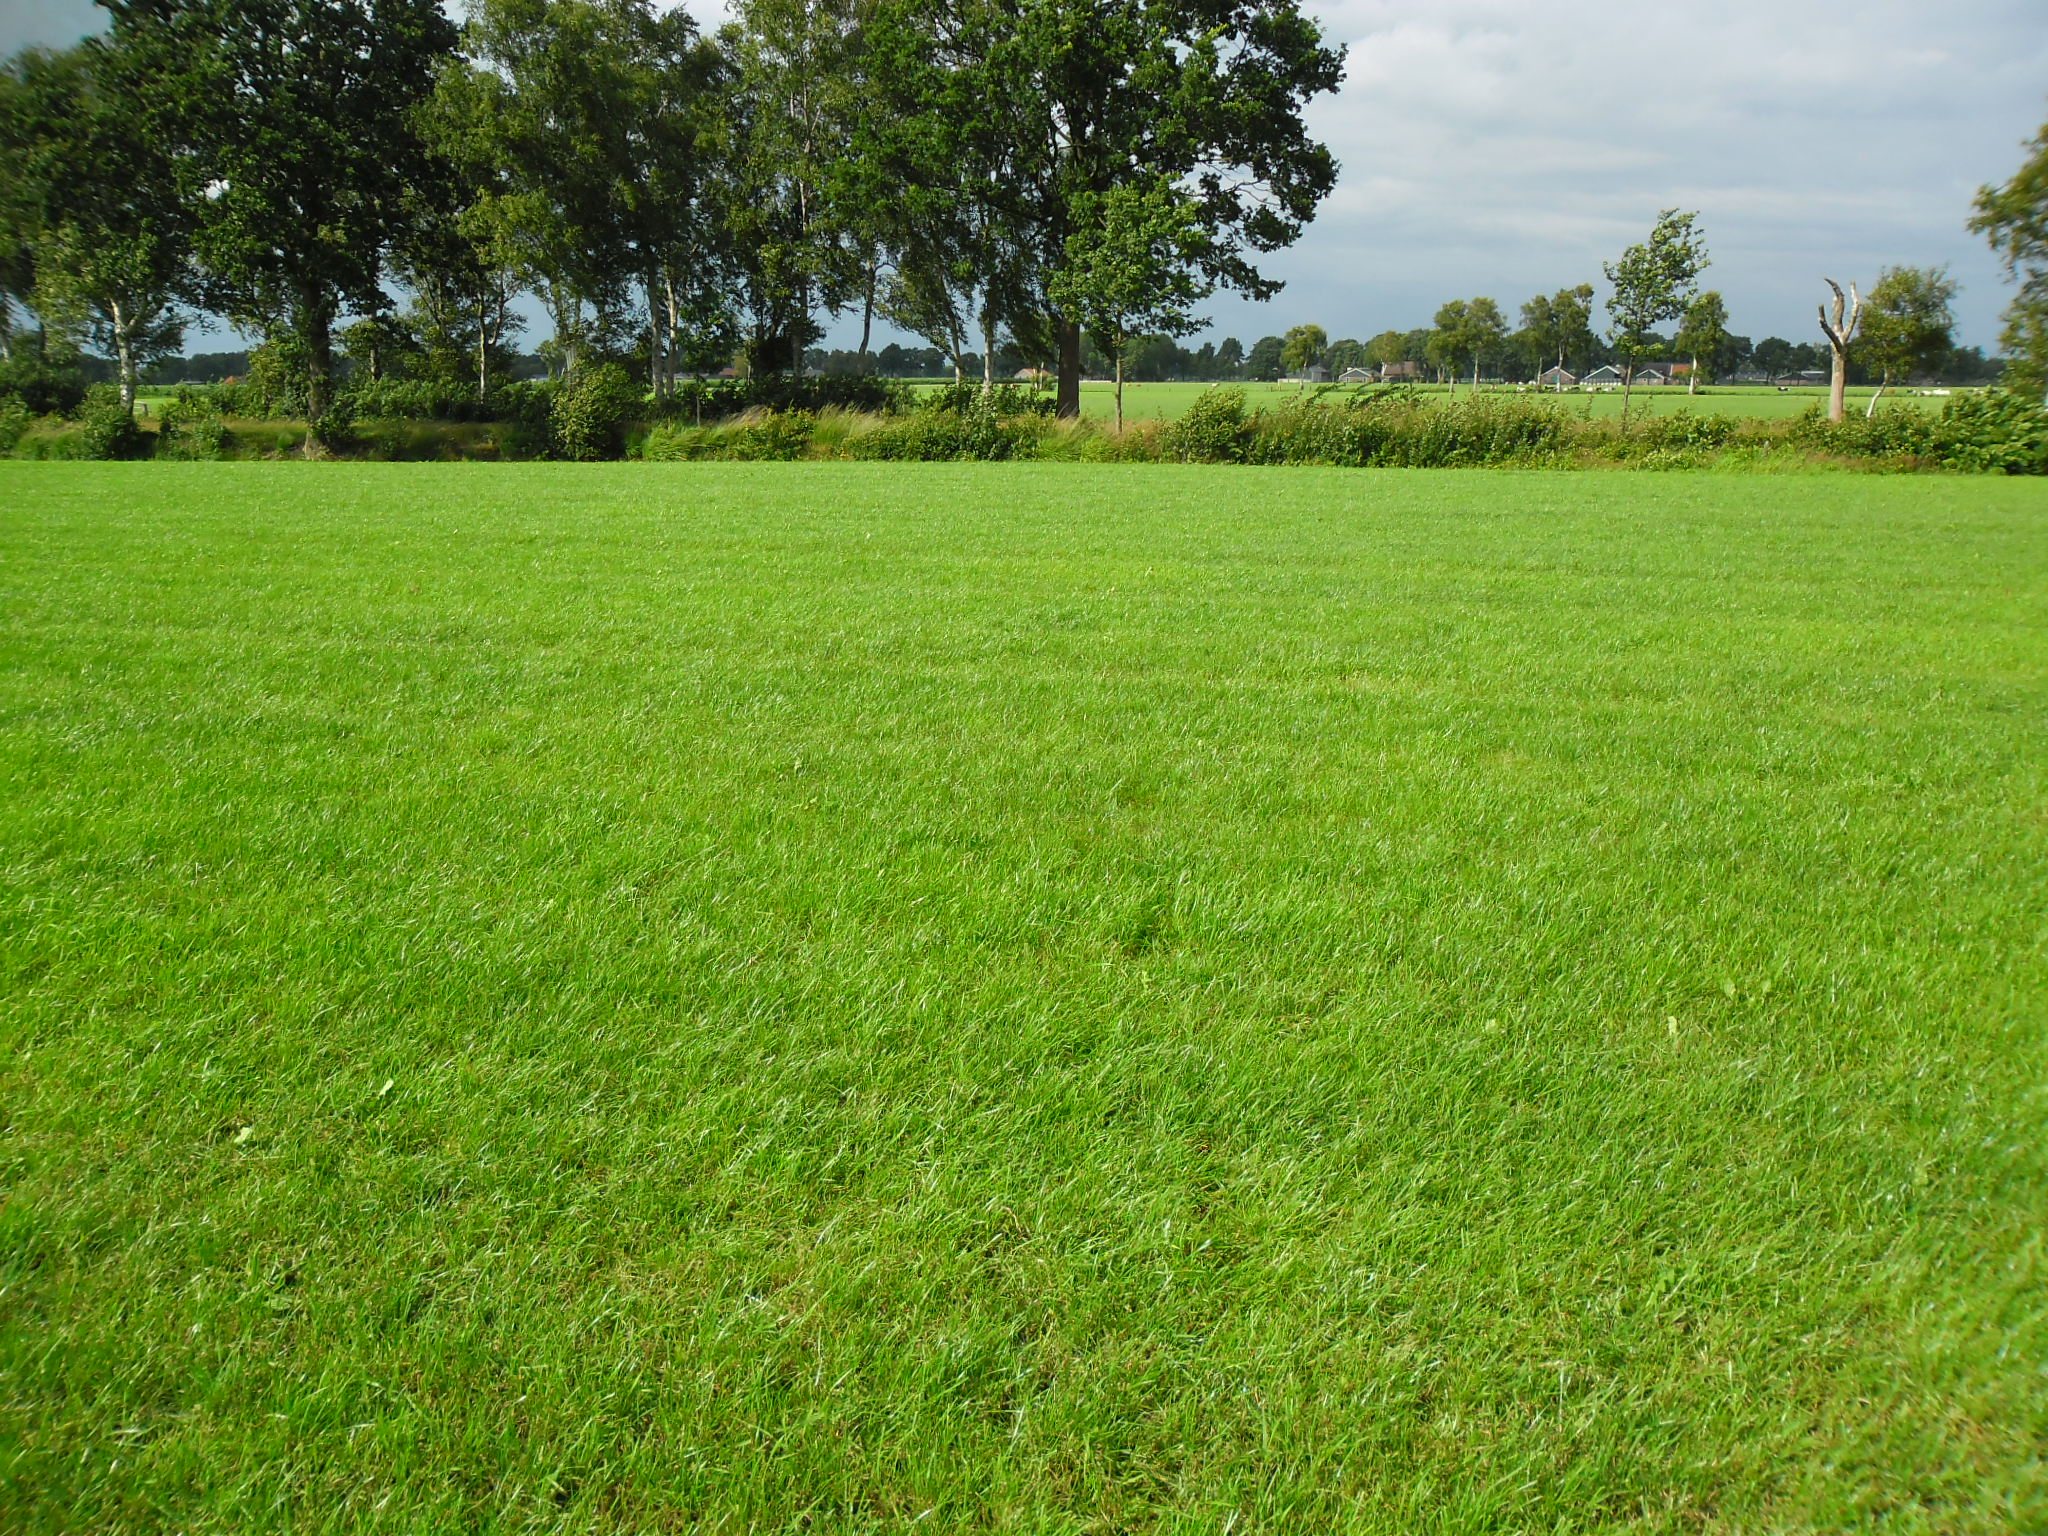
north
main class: Grassland
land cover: Grassland without tree/shrub cover
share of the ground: > 75 %
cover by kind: herbaceous plants 100 %
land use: Agriculture (excluding fallow land and kitchen gardens)
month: July
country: NL
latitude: 52.6057
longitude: 6.2342
